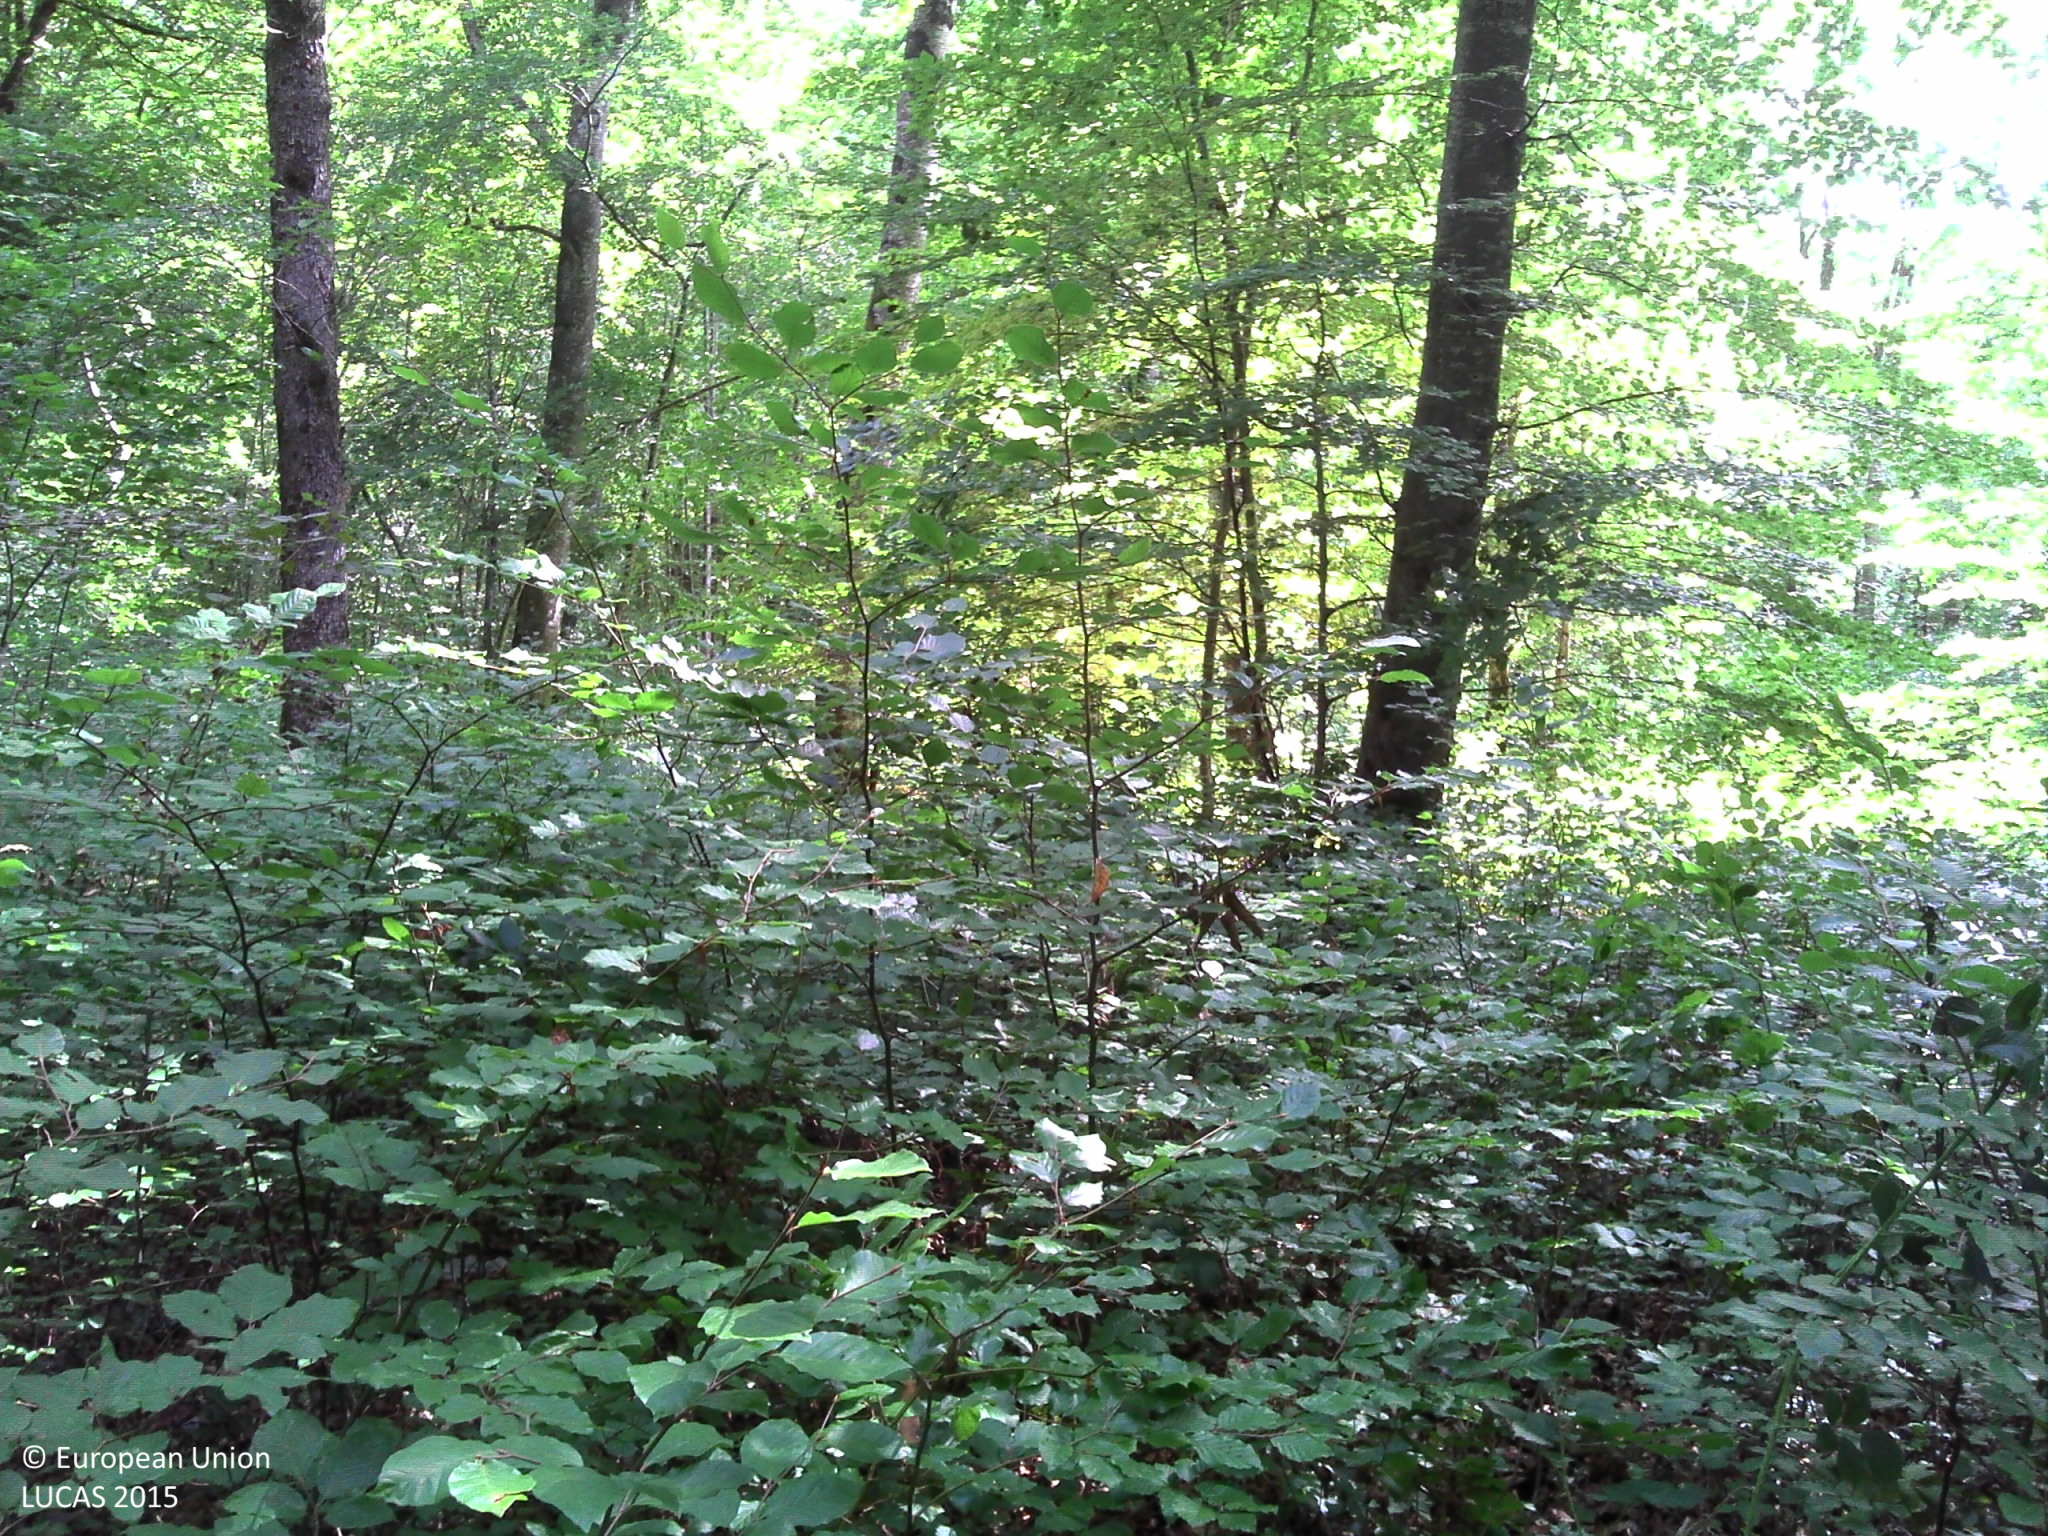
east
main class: Woodland
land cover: Broadleaved woodland
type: mesophytic deciduous forest
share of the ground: > 75 %
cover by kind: broadleaved forest trees 90 %, herbaceous plants 5 %, lichens and mosses 5 %
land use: Forestry
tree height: > 5 m
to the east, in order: Broadleaved woodland
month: August
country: FR
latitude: 47.8472
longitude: 4.7739
